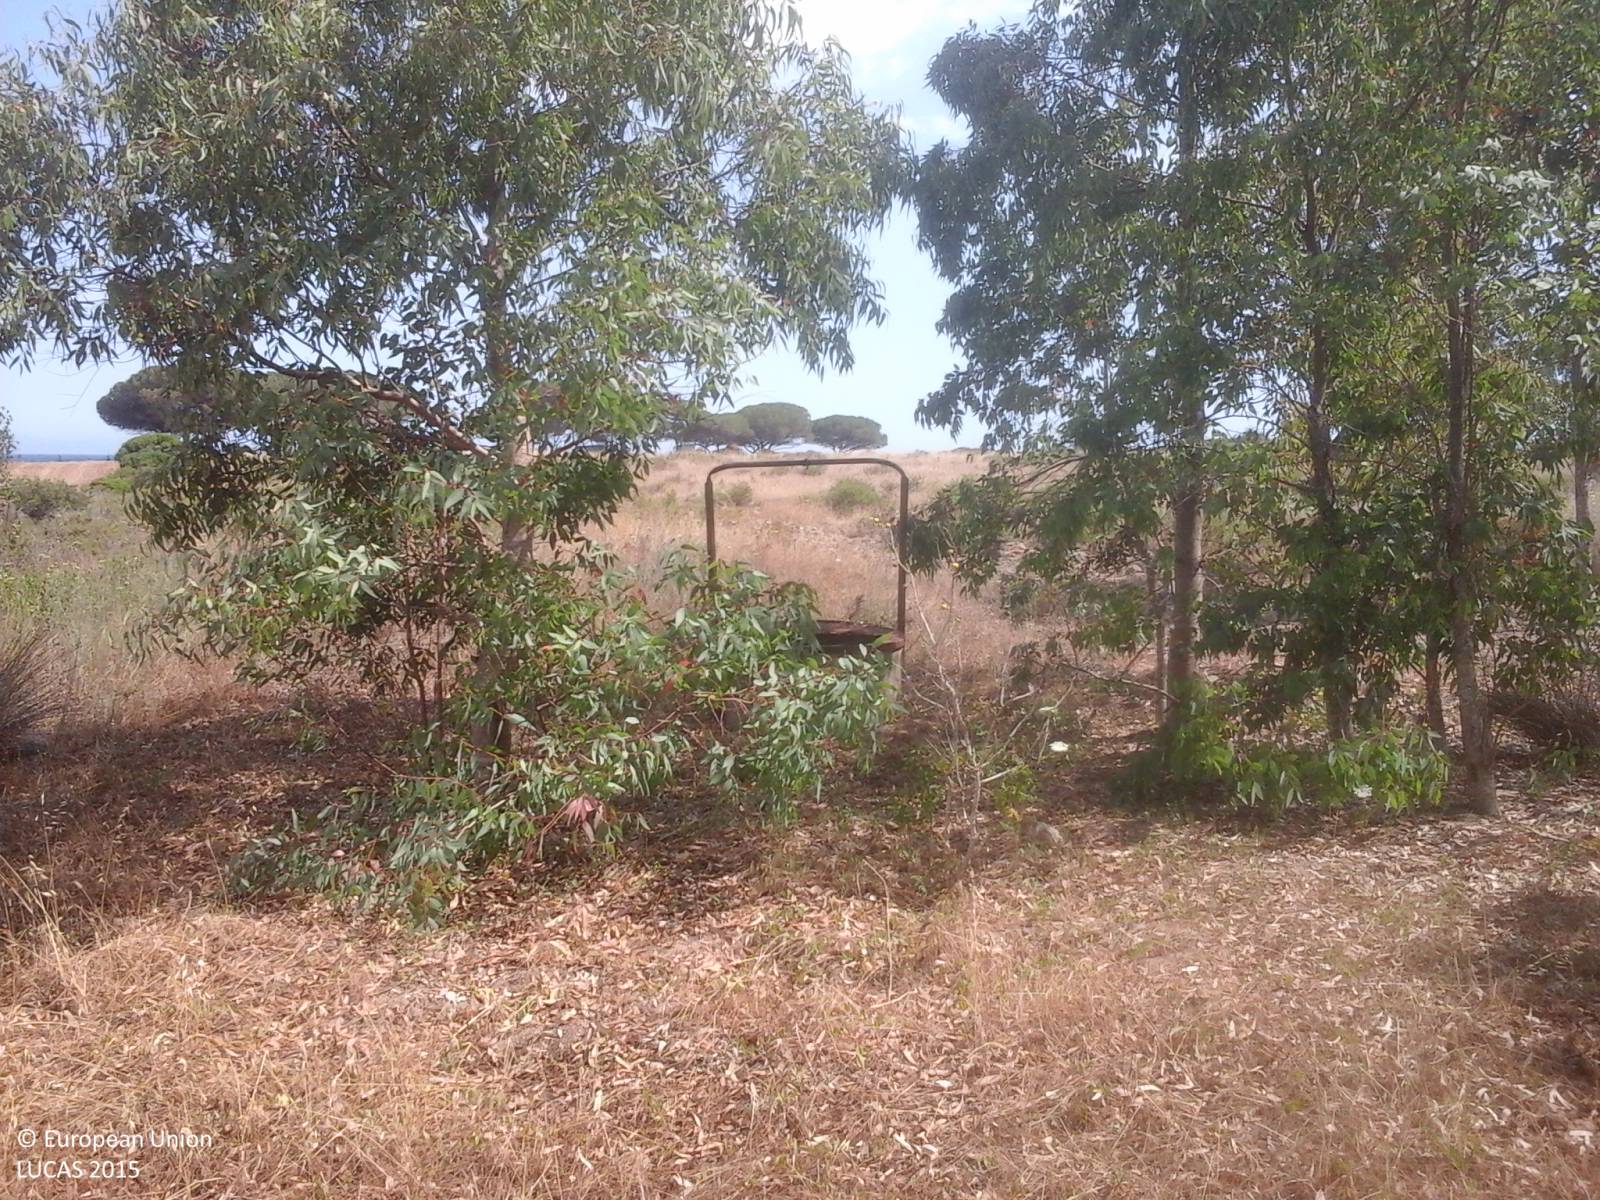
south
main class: Cropland
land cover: Common wheat
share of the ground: > 75 %
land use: Agriculture (excluding fallow land and kitchen gardens)
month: June
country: IT
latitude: 39.2885
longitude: 9.5967
